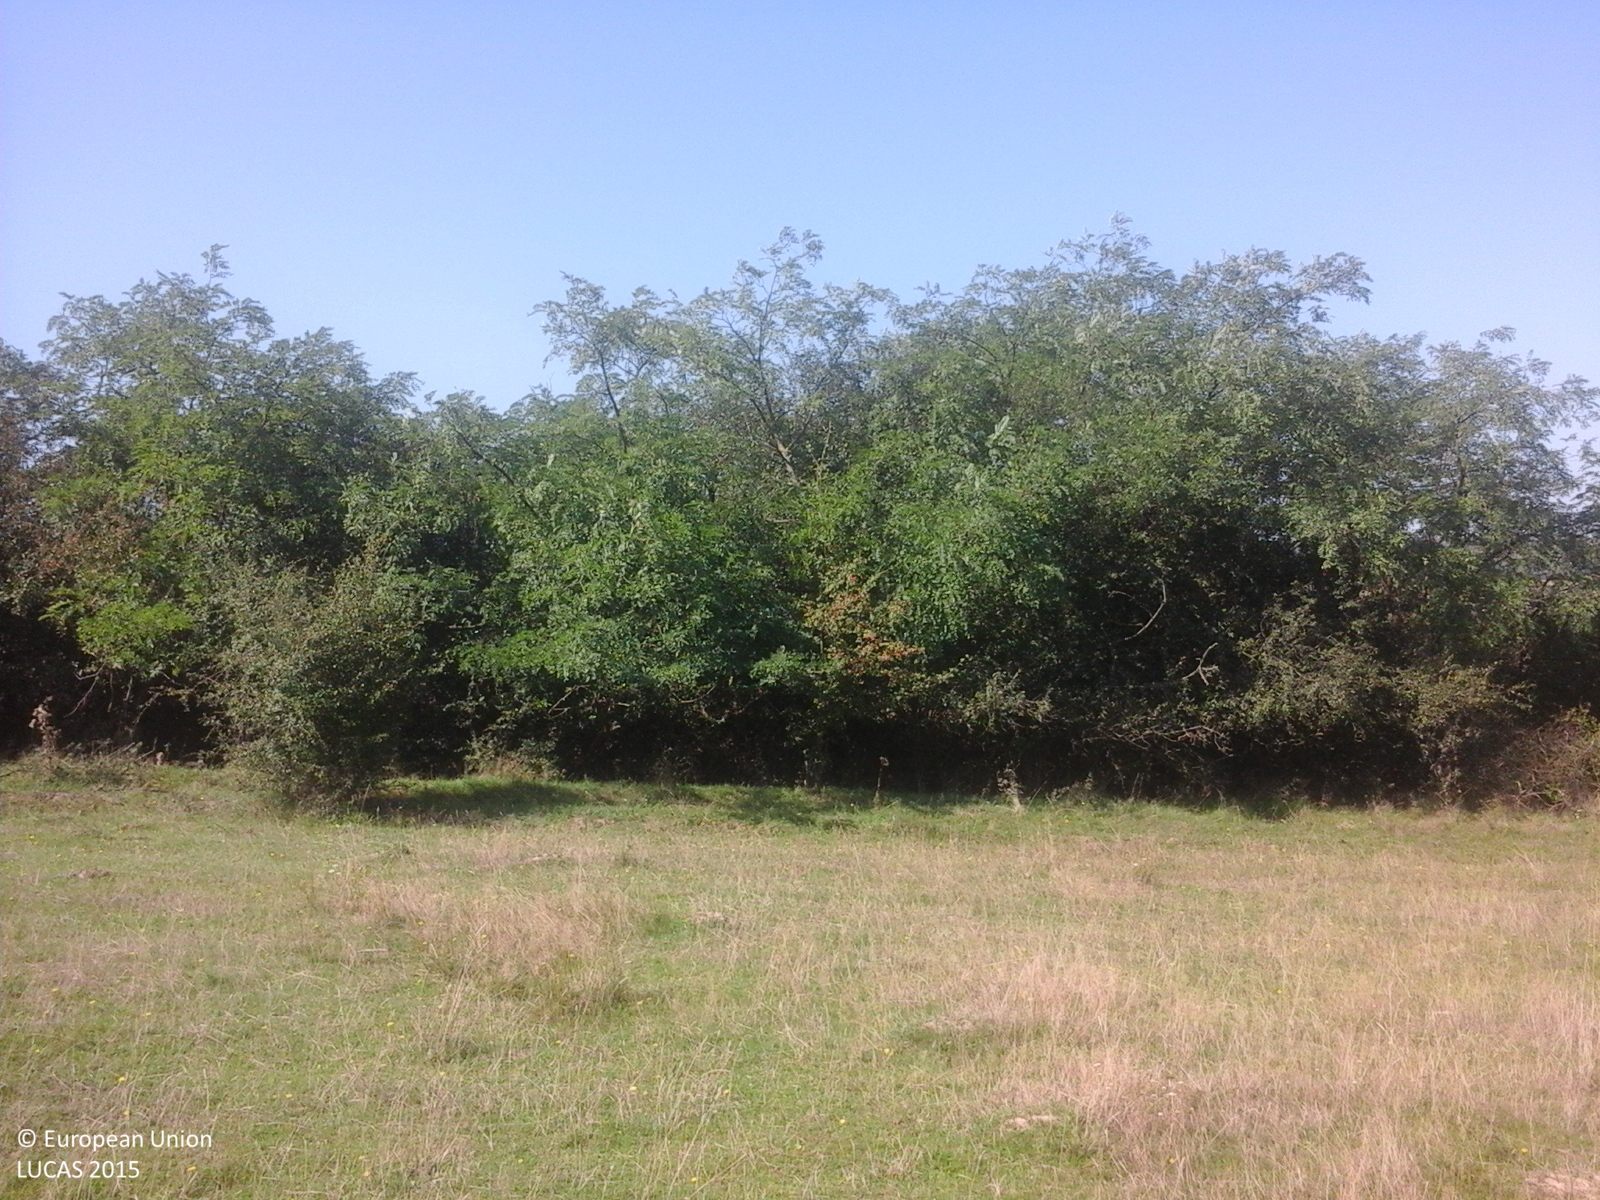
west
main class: Grassland
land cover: Grassland without tree/shrub cover
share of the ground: > 75 %
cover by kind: herbaceous plants 100 %
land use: Agriculture (excluding fallow land and kitchen gardens)
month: September
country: RO
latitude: 47.4076
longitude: 22.7425
